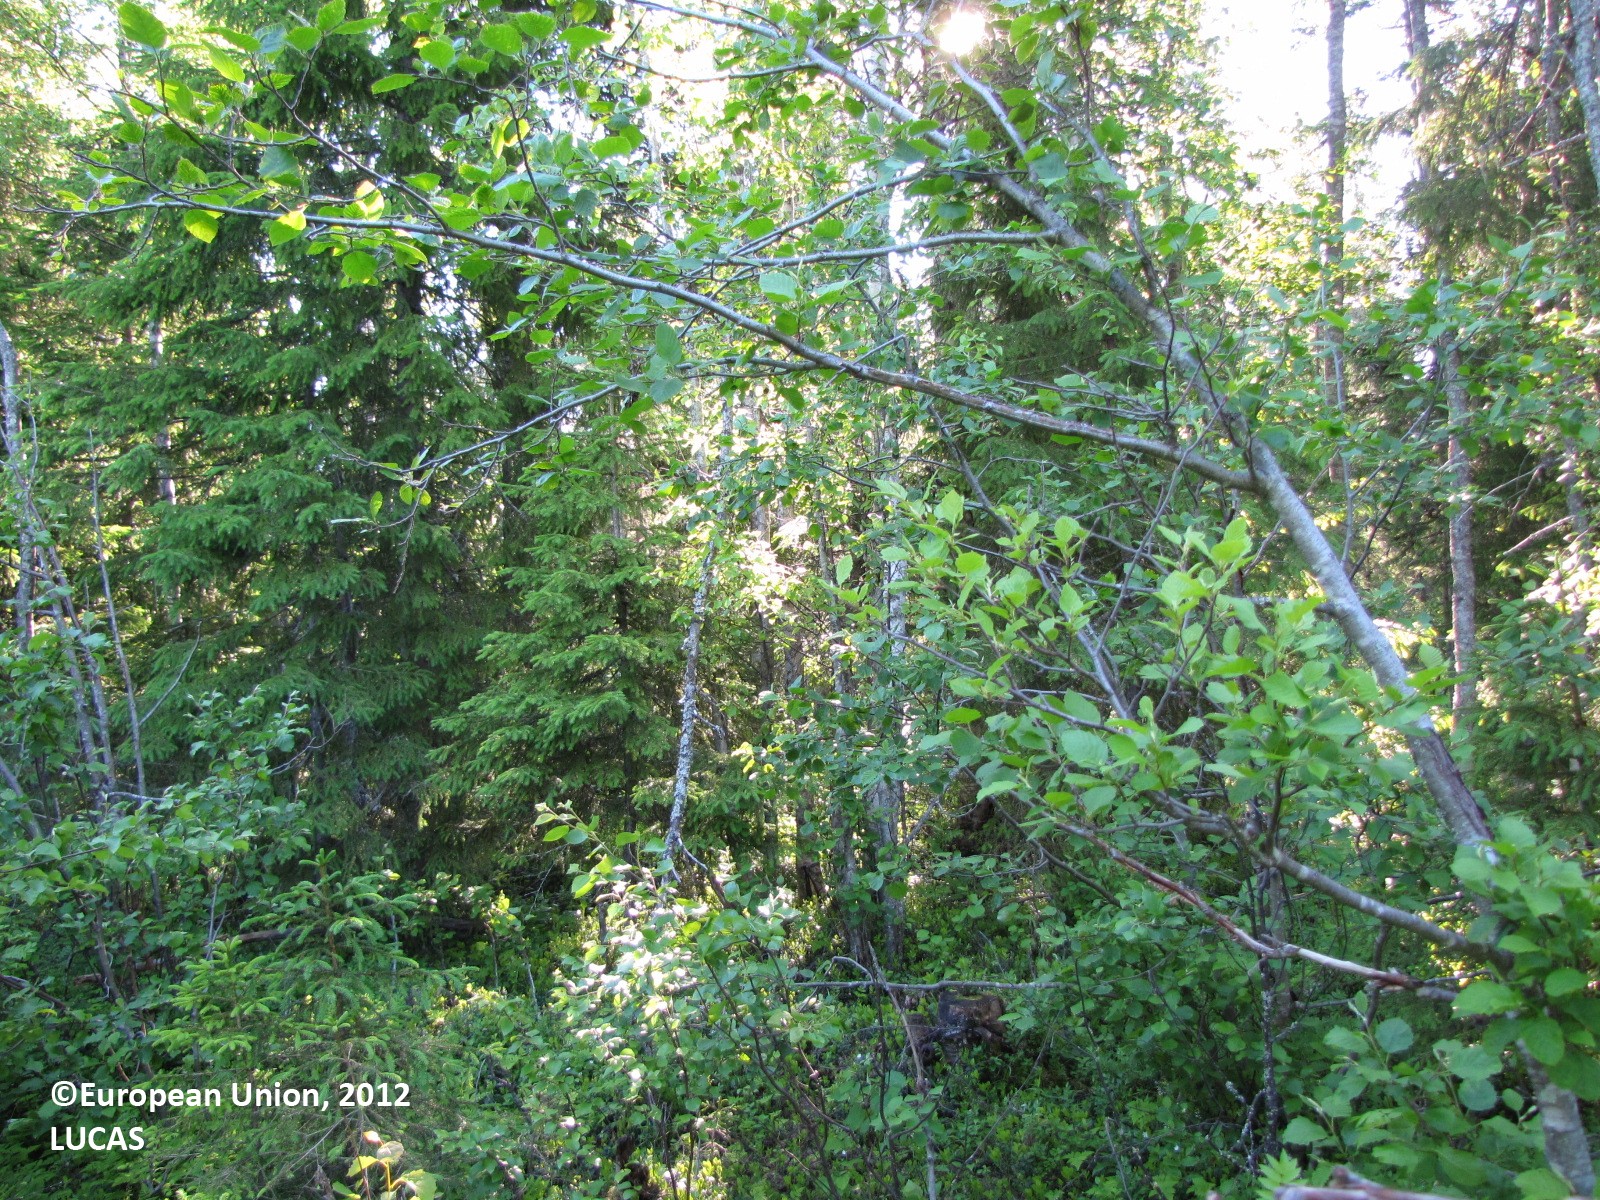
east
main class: Woodland
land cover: Spruce dominated mixed woodland
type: boreal forest
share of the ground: 25 - 50 %
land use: Forestry
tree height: > 5 m
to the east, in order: Spruce dominated mixed woodland; Other mixed woodland; Tracks; Spruce dominated mixed woodland; Spruce dominated coniferous woodland
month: July
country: FI
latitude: 66.1020
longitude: 24.1351
